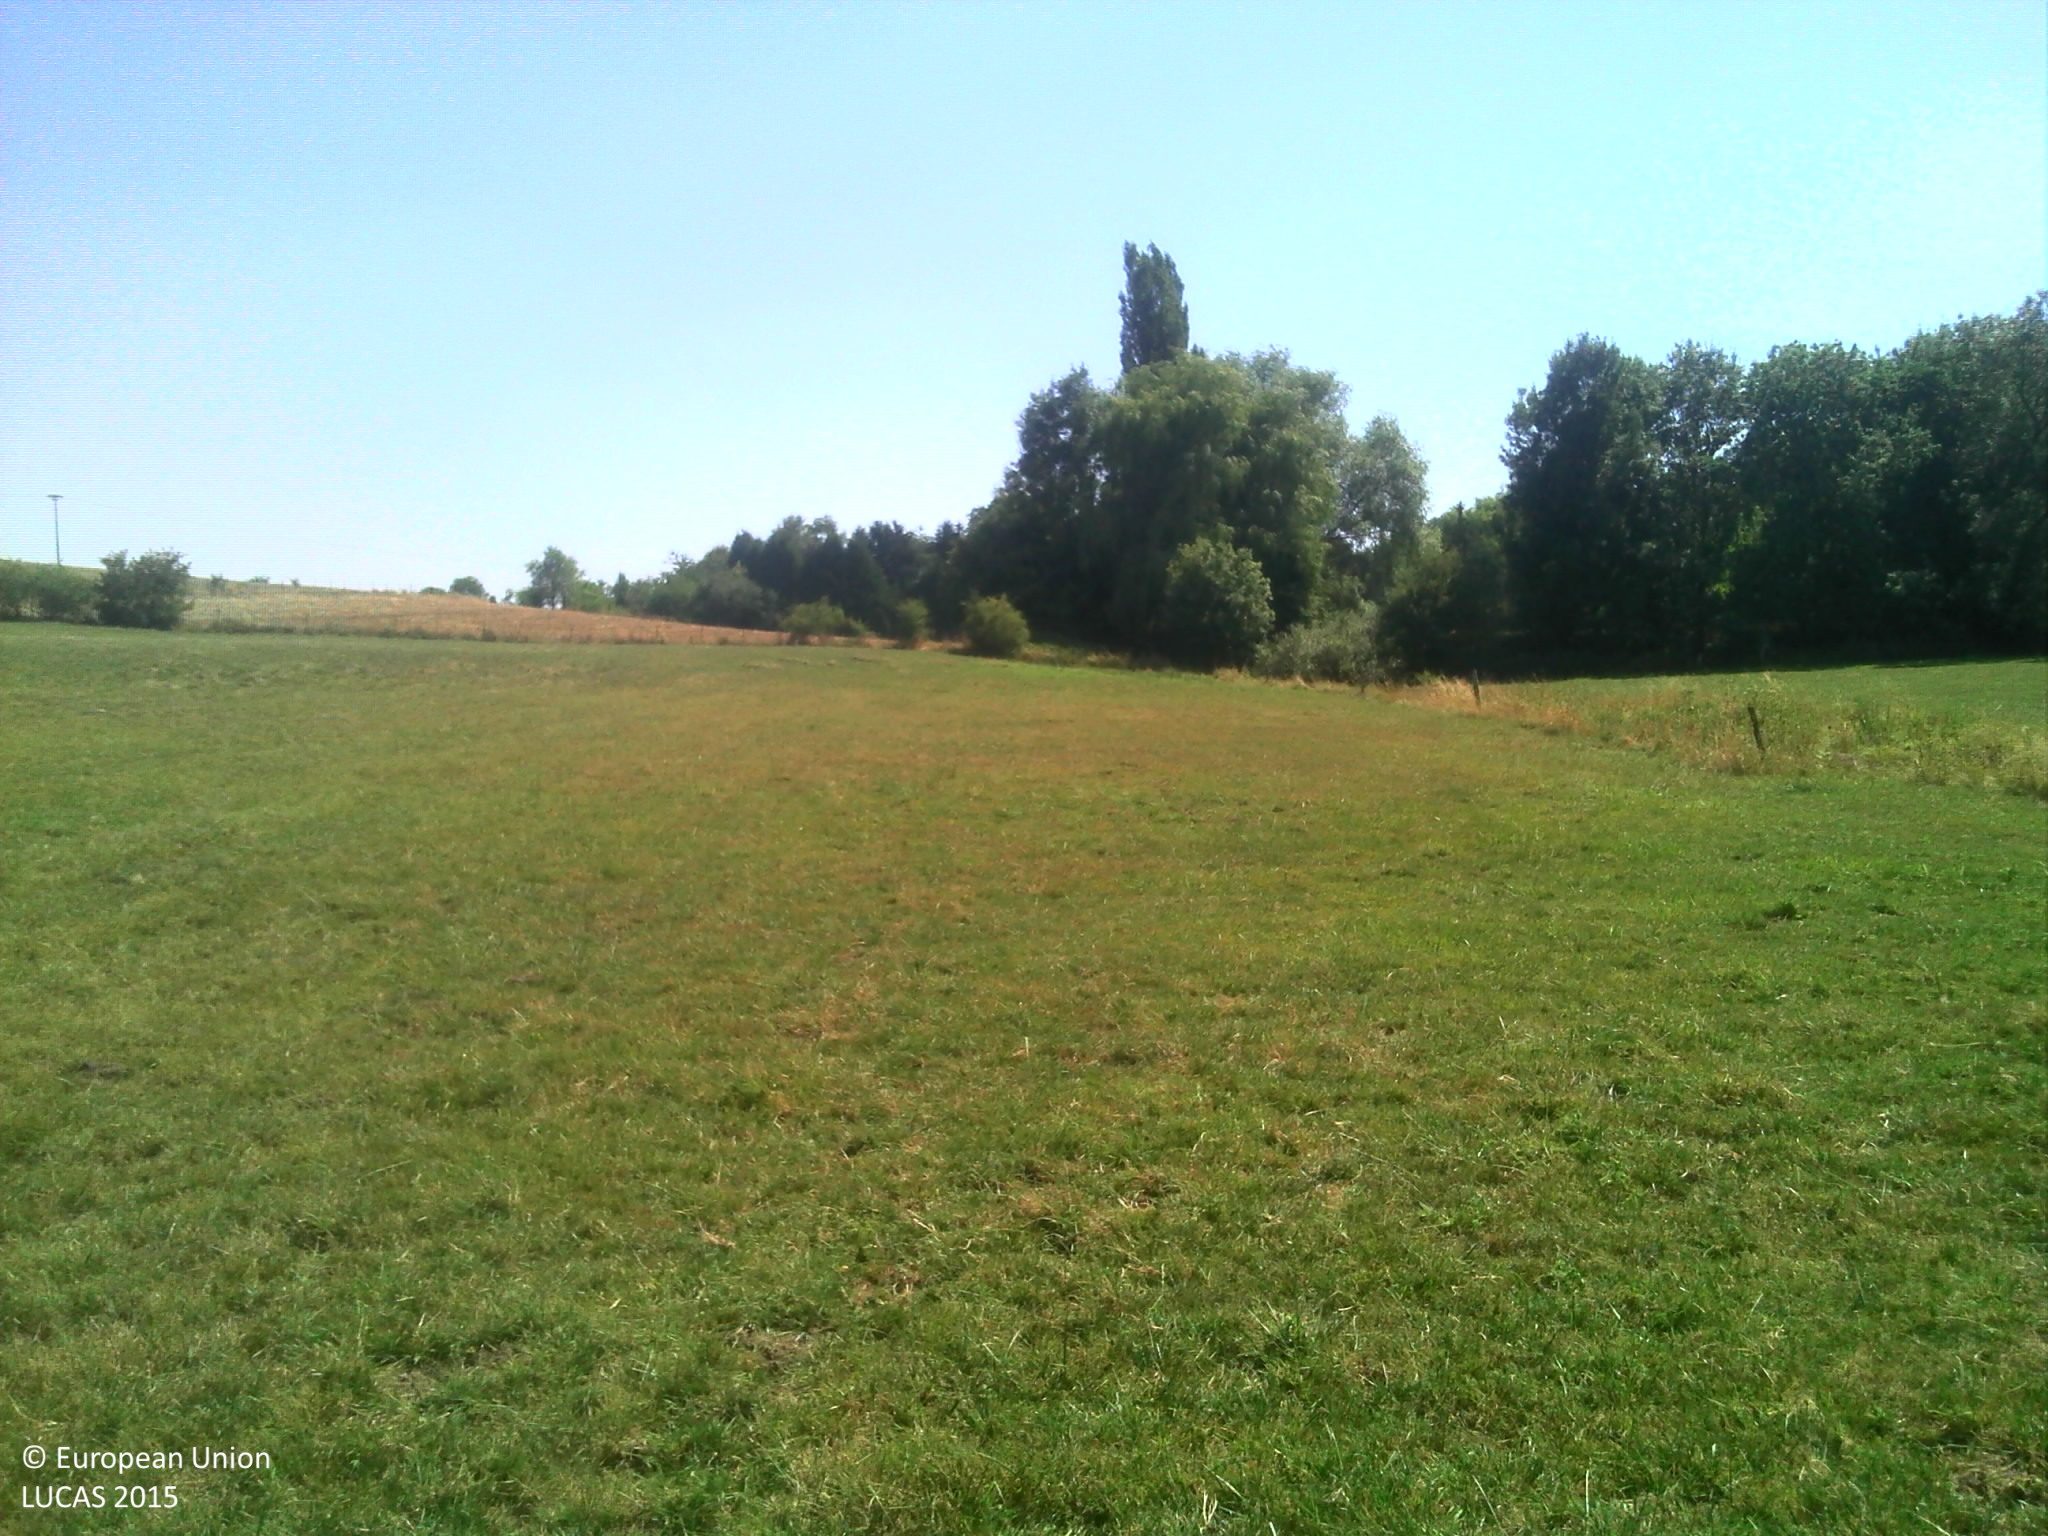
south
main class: Grassland
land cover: Grassland without tree/shrub cover
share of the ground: > 75 %
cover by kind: herbaceous plants 100 %
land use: Agriculture (excluding fallow land and kitchen gardens)
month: August
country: FR
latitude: 49.2881
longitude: 5.1447
